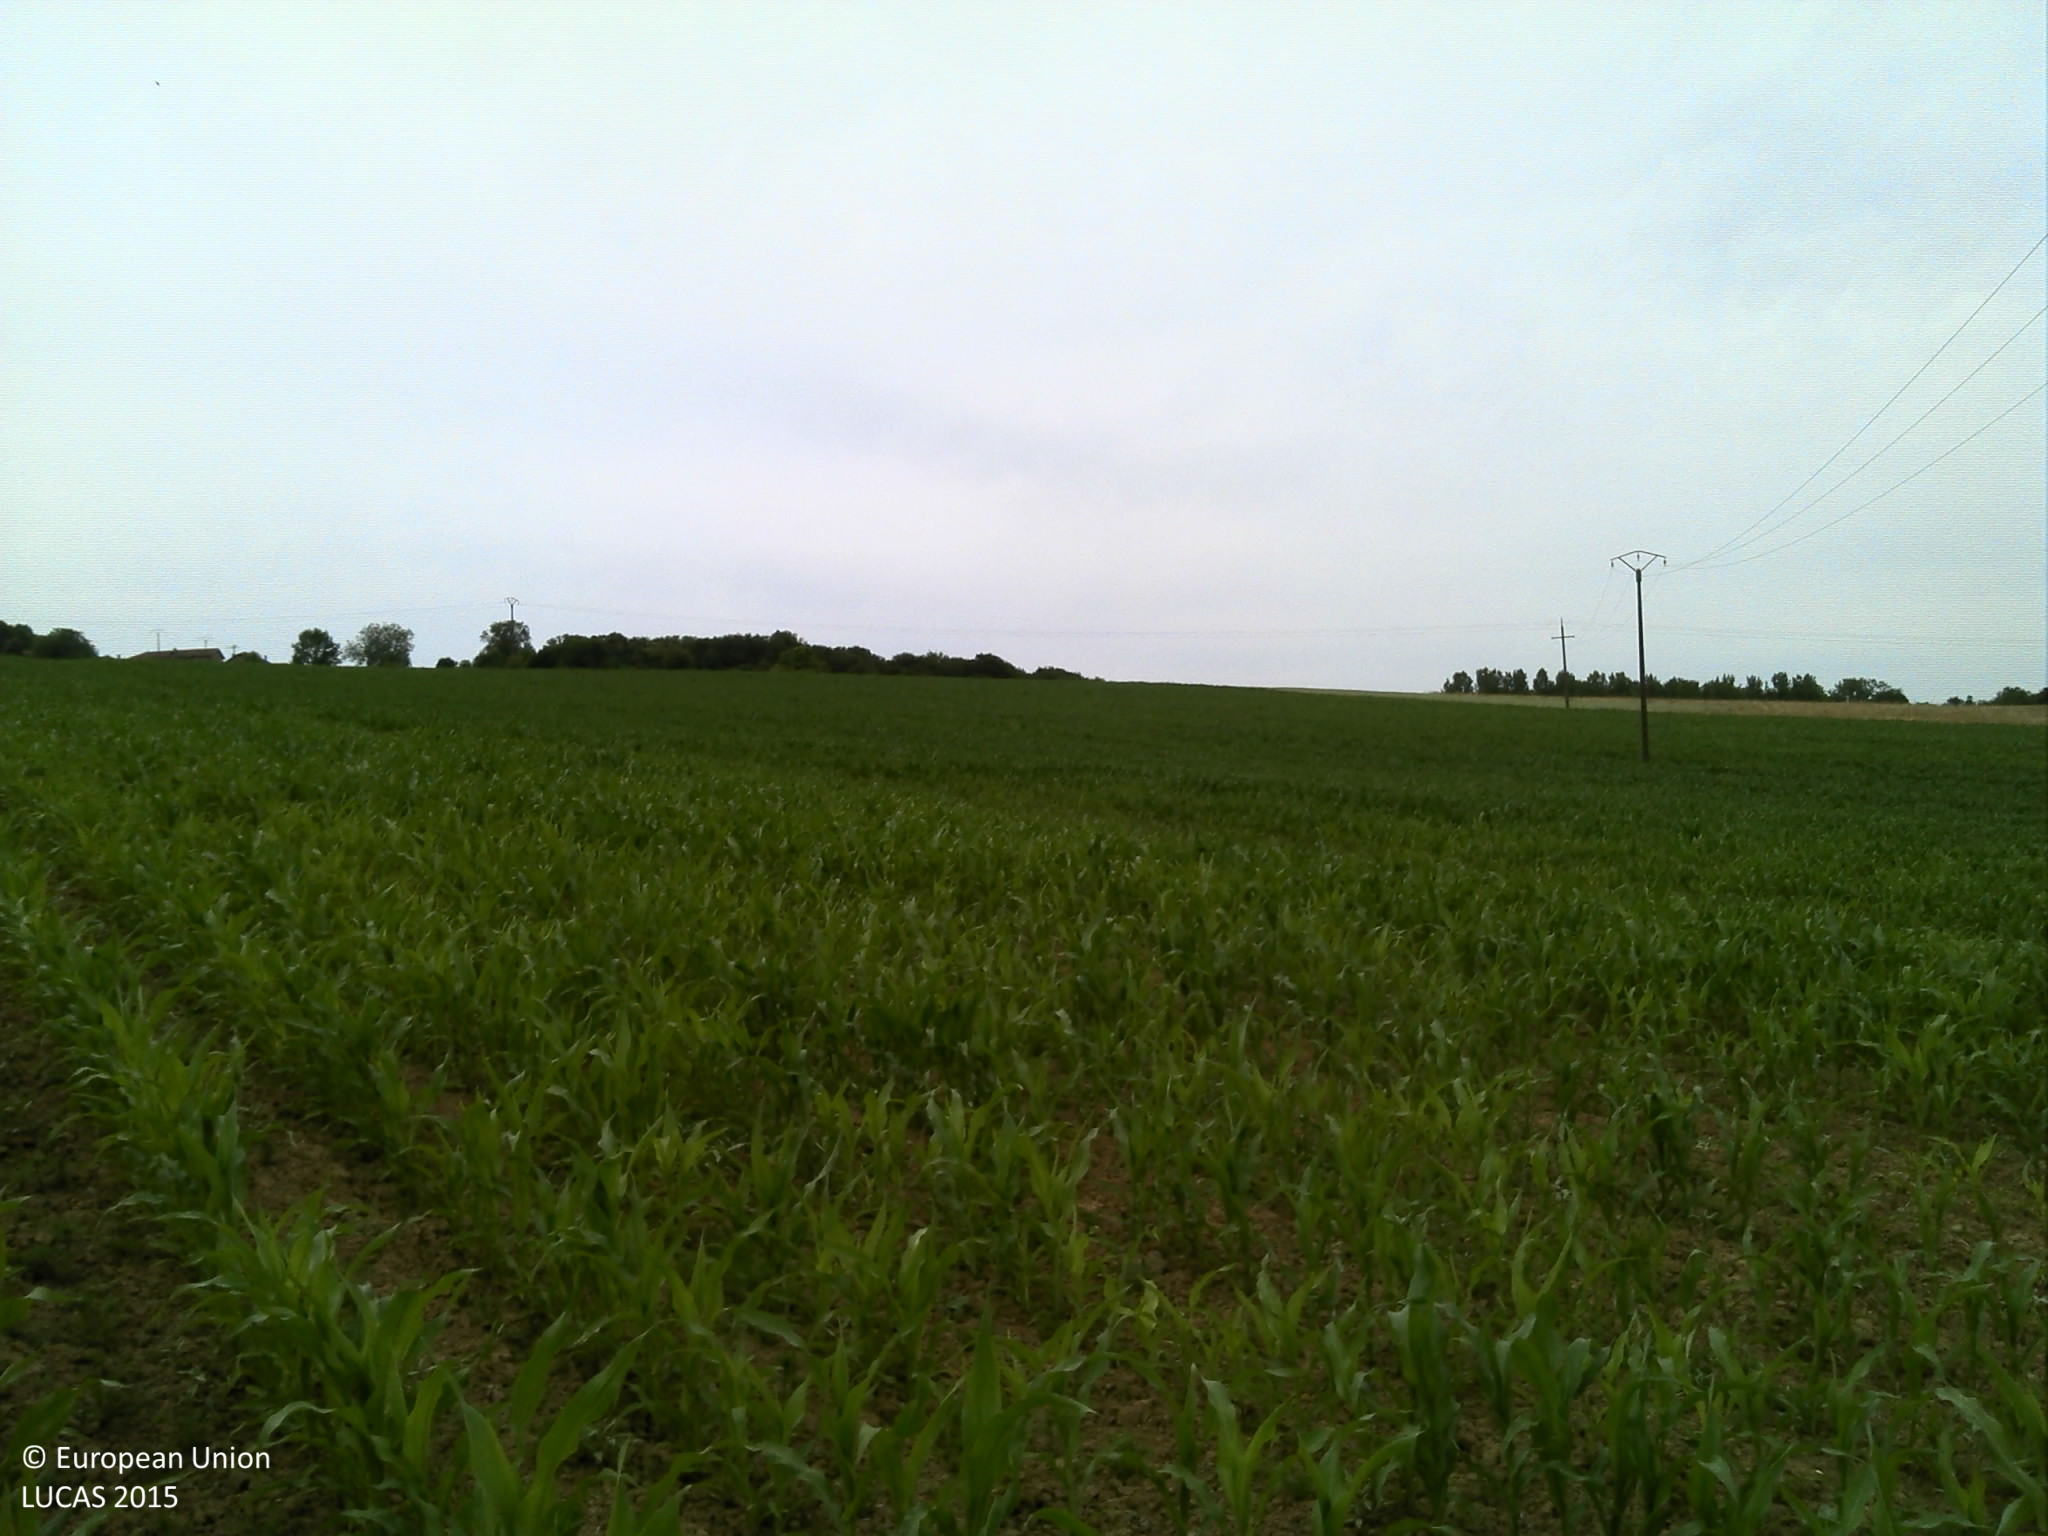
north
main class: Cropland
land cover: Maize
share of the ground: 25 - 50 %
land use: Agriculture (excluding fallow land and kitchen gardens)
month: June
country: FR
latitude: 49.6110
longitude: 5.1124
